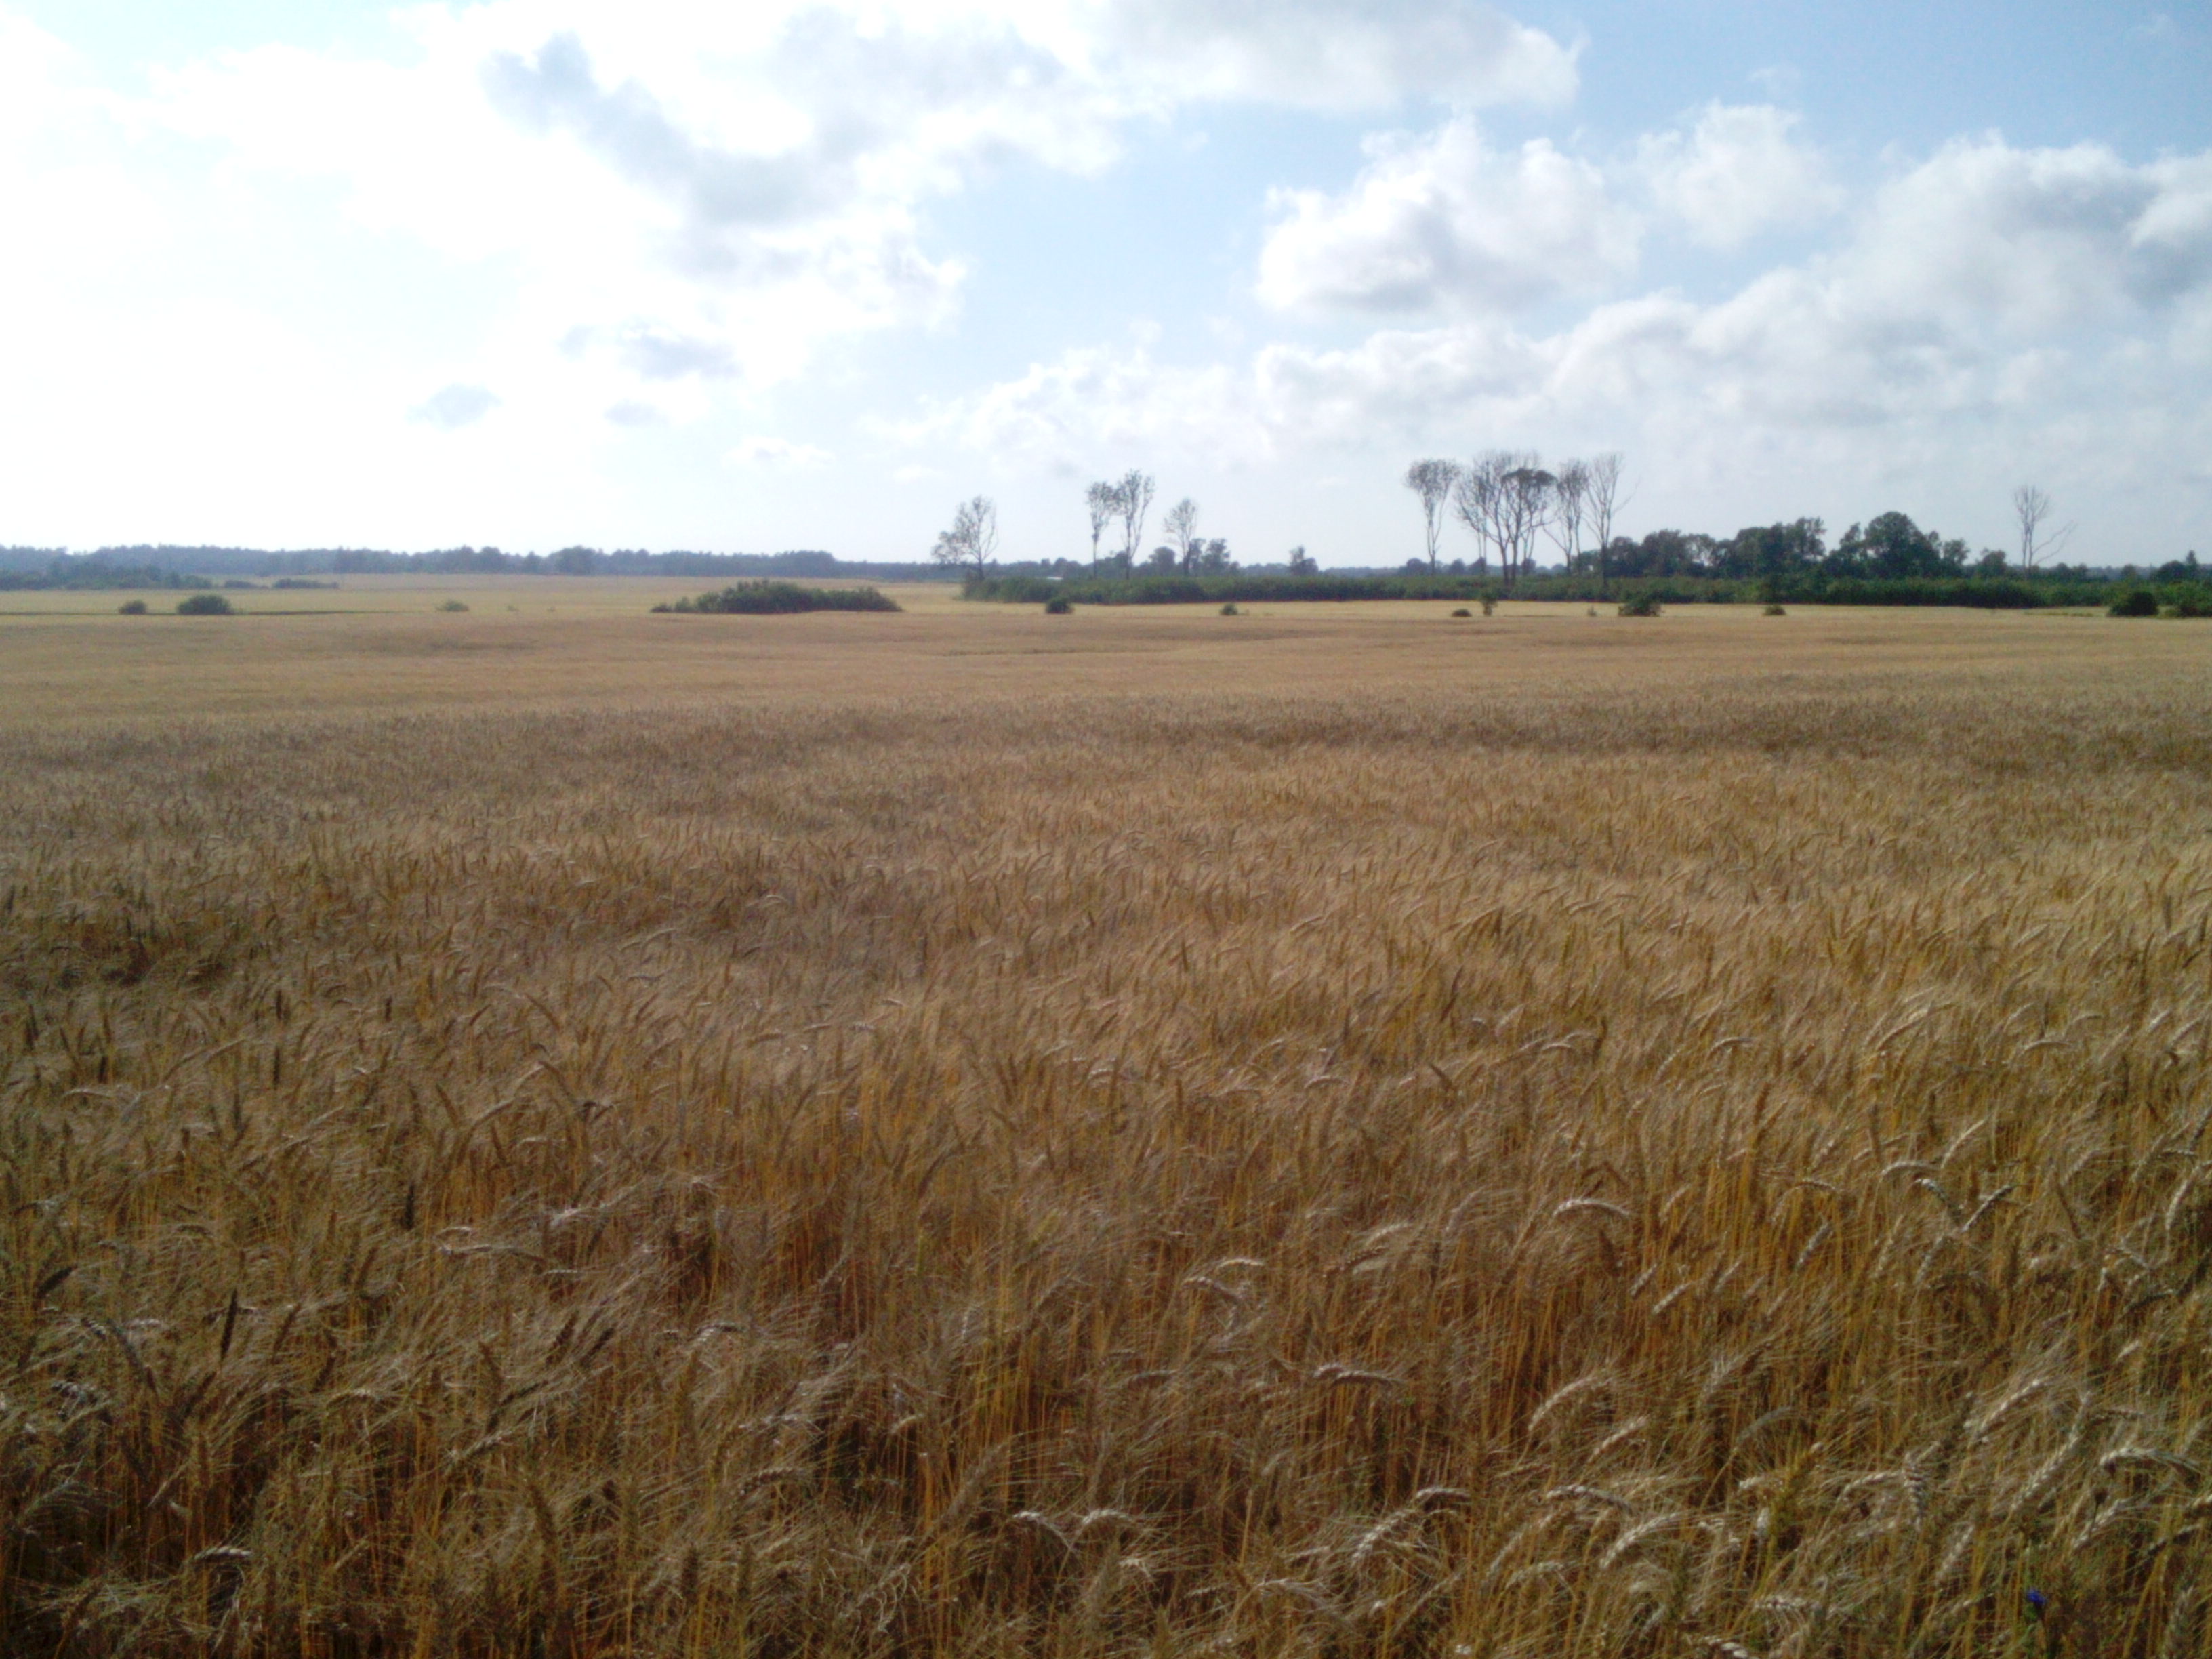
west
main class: Cropland
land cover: Common wheat
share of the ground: > 75 %
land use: Agriculture (excluding fallow land and kitchen gardens)
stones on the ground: 10 - 25 %
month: July
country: LV
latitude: 56.6494
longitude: 21.3090
